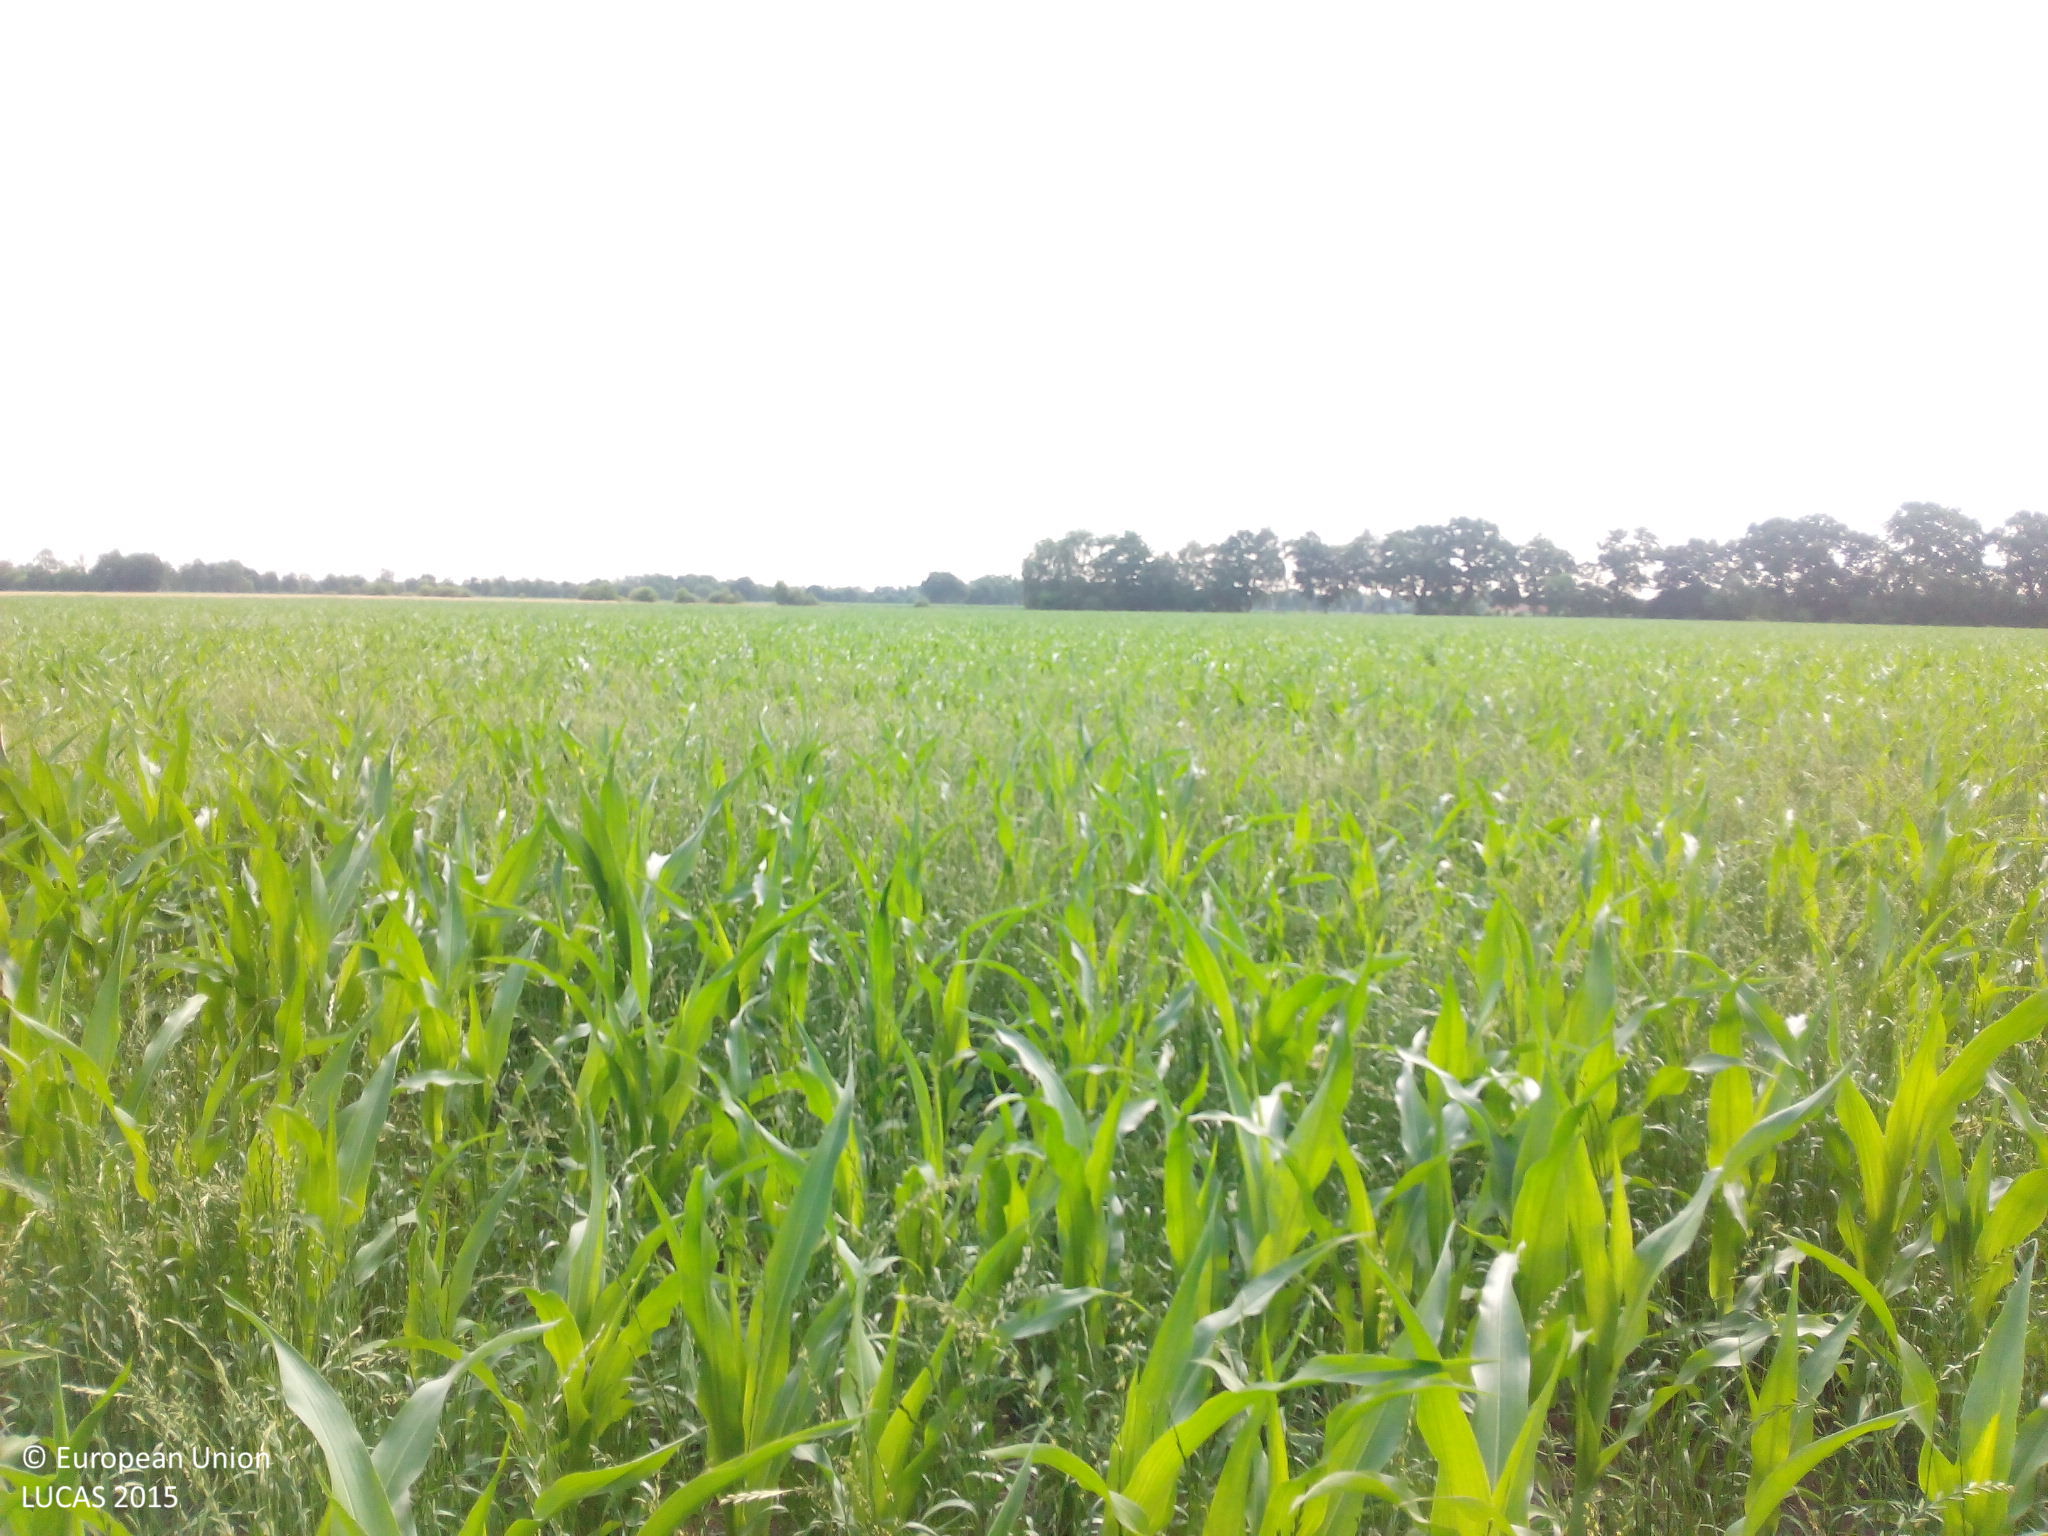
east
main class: Cropland
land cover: Maize
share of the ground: > 75 %
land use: Agriculture (excluding fallow land and kitchen gardens)
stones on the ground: < 10 %
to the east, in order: Maize
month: July
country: DE
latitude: 52.7256
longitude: 7.3500
